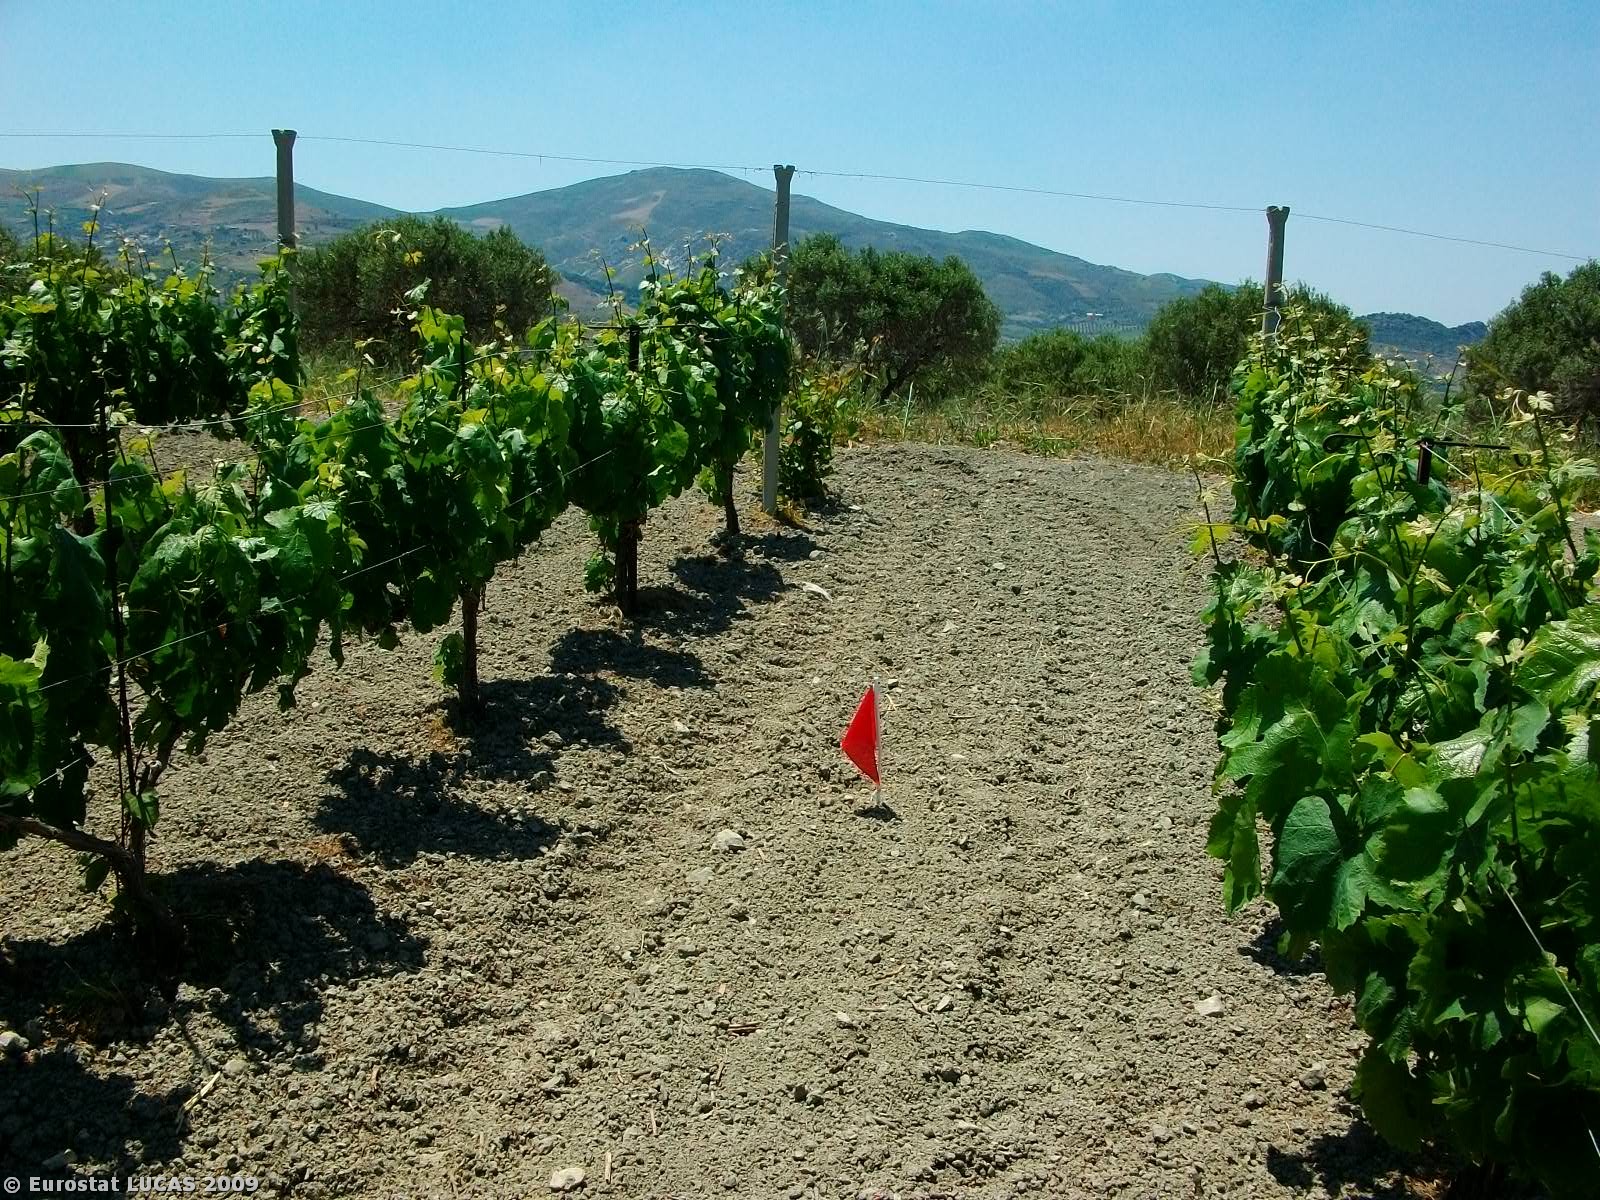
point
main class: Cropland
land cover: Vineyards
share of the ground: 25 - 50 %
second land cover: Bare land
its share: > 75 %
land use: Agriculture (excluding fallow land and kitchen gardens)
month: May
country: GR
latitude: 35.1834
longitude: 25.1334
